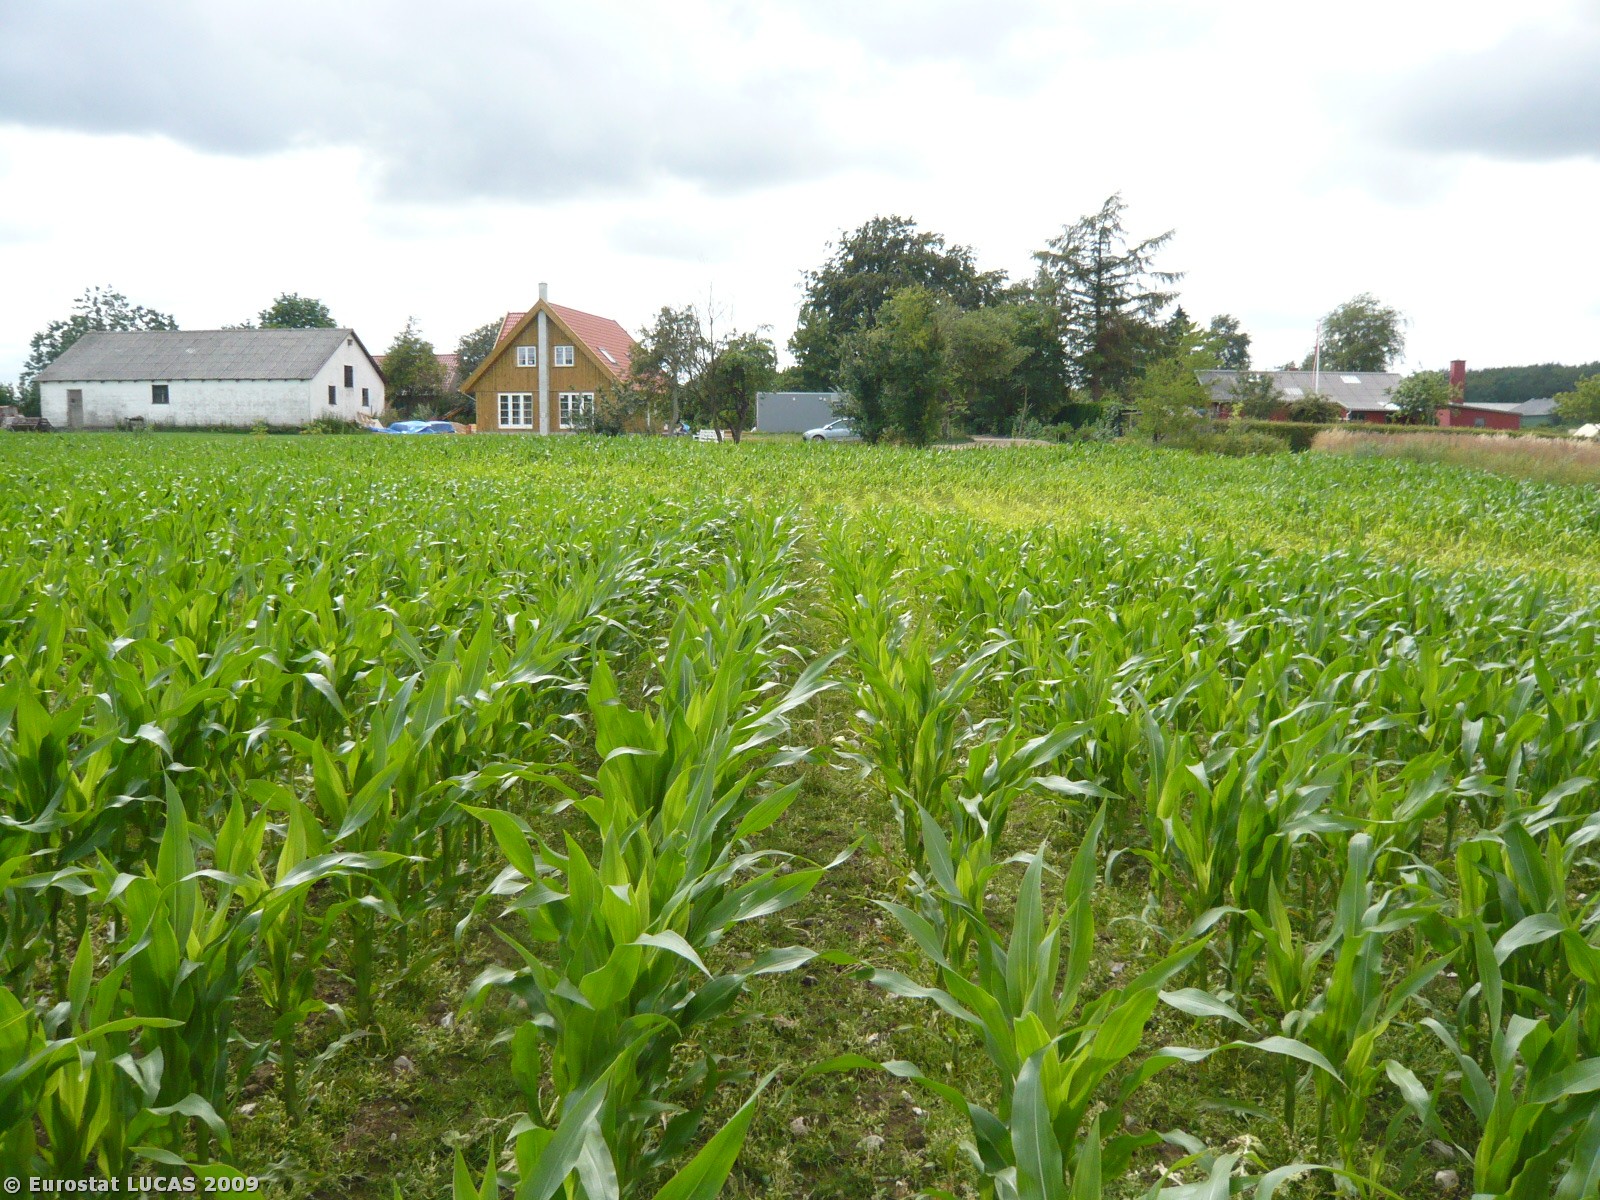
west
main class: Cropland
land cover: Maize
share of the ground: > 75 %
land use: Agriculture (excluding fallow land and kitchen gardens)
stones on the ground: < 10 %
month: July
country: DK
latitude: 55.5267
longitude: 11.8835
